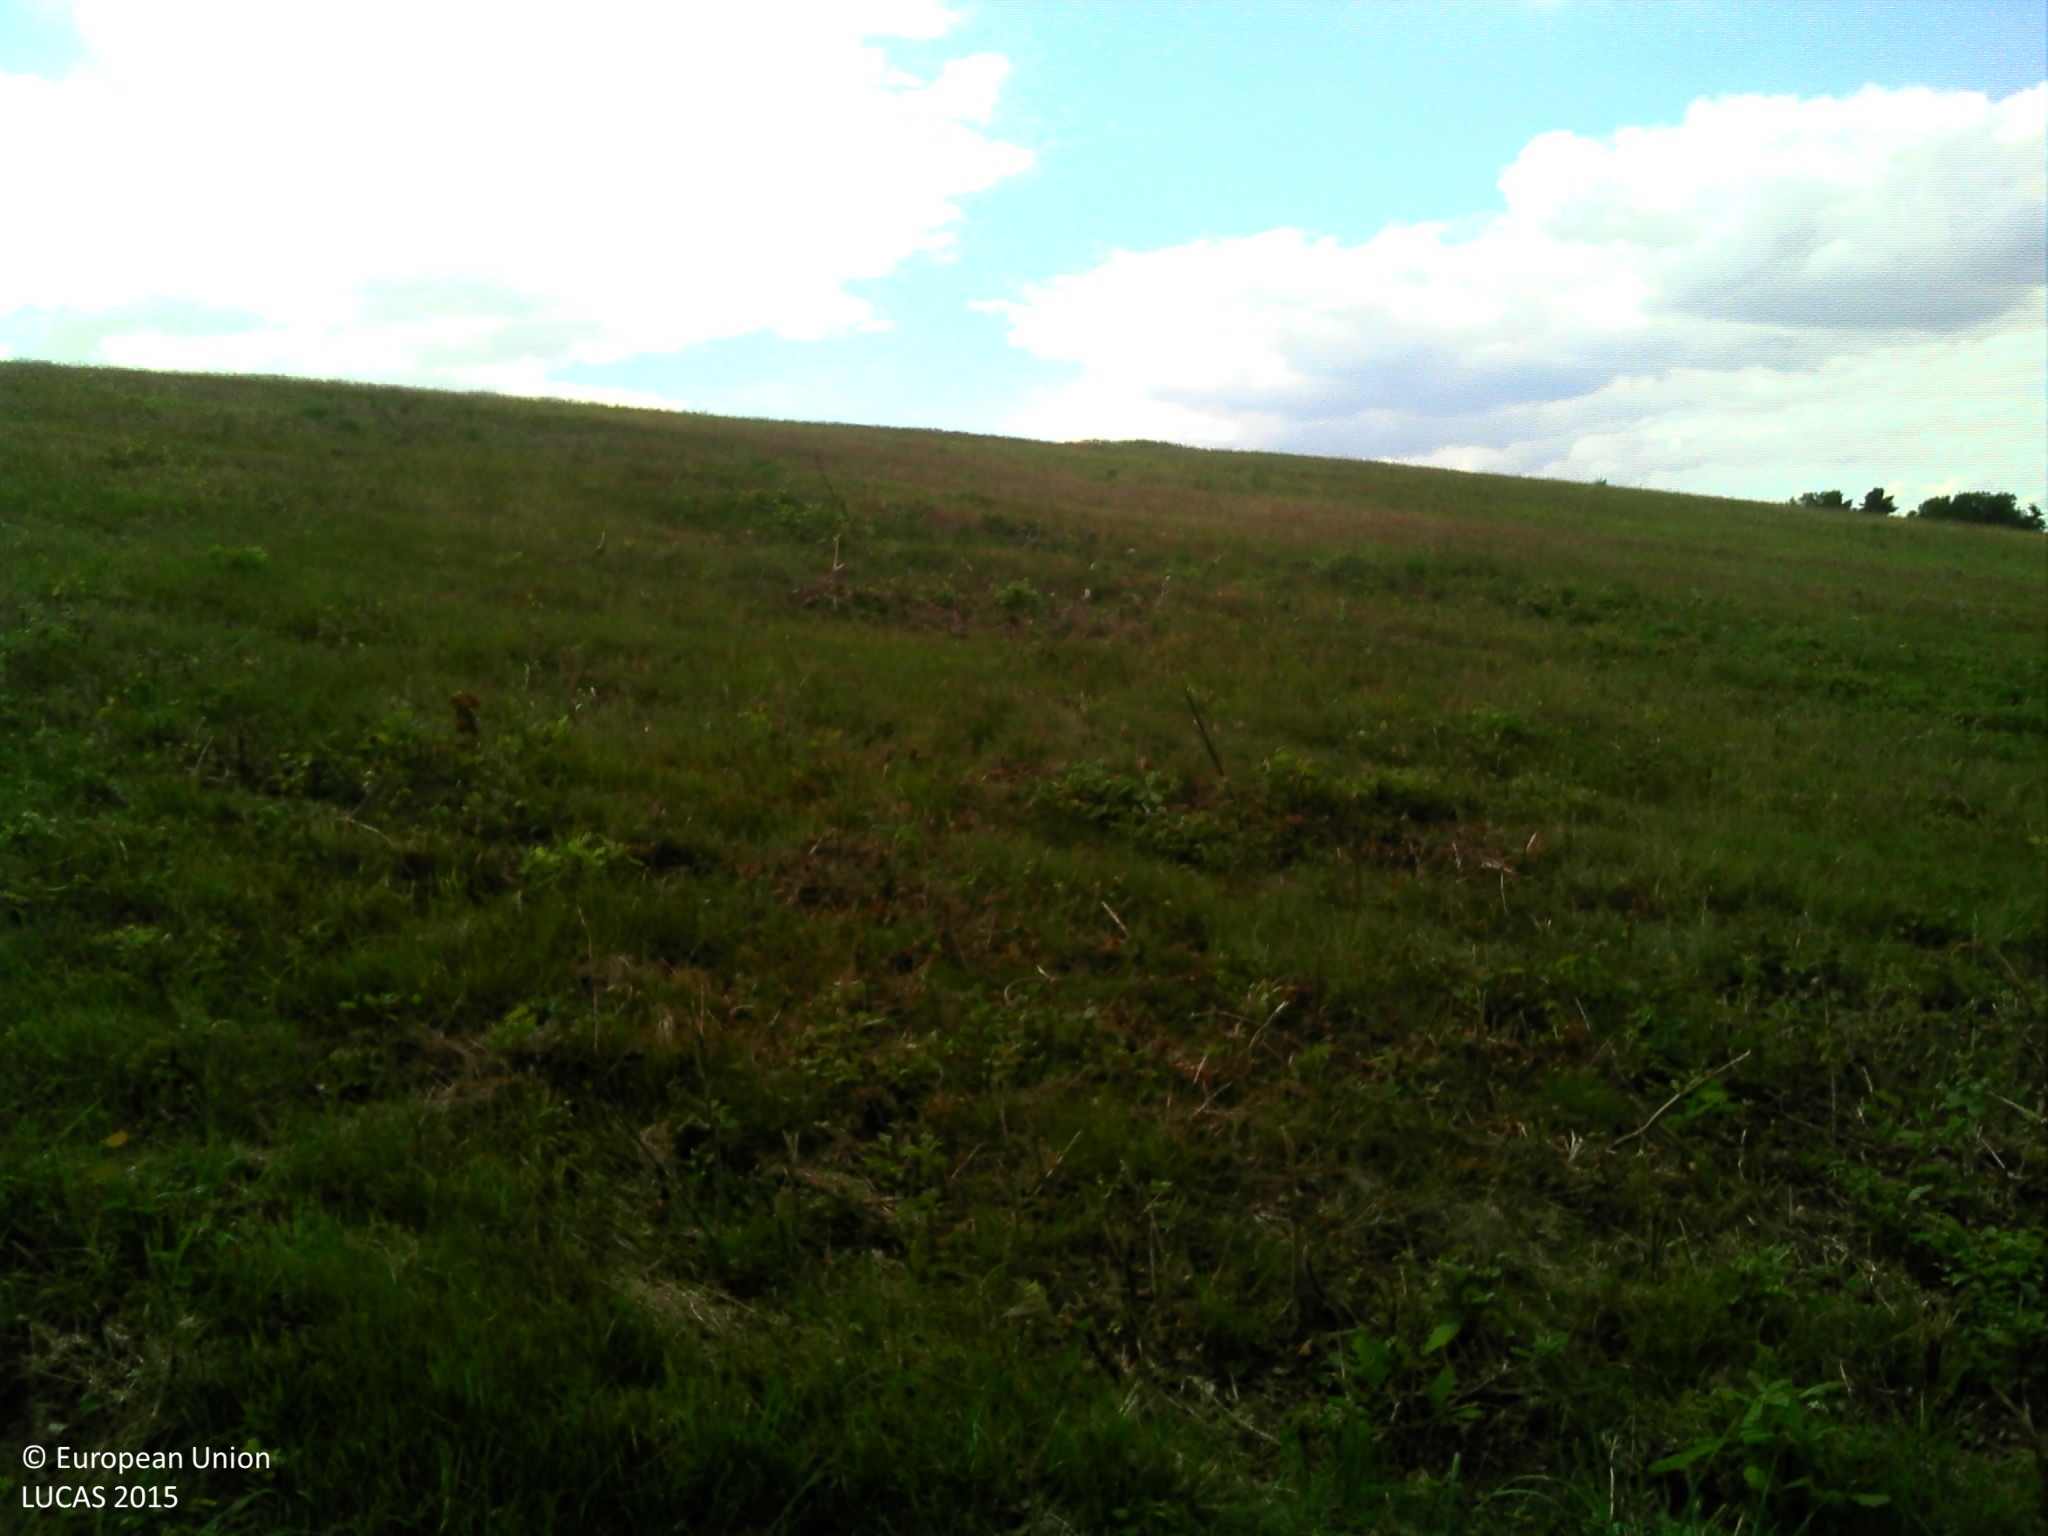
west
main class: Grassland
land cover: Grassland without tree/shrub cover
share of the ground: > 75 %
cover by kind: herbaceous plants 100 %
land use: Agriculture (excluding fallow land and kitchen gardens)
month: June
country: FR
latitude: 47.3113
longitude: 2.6783
